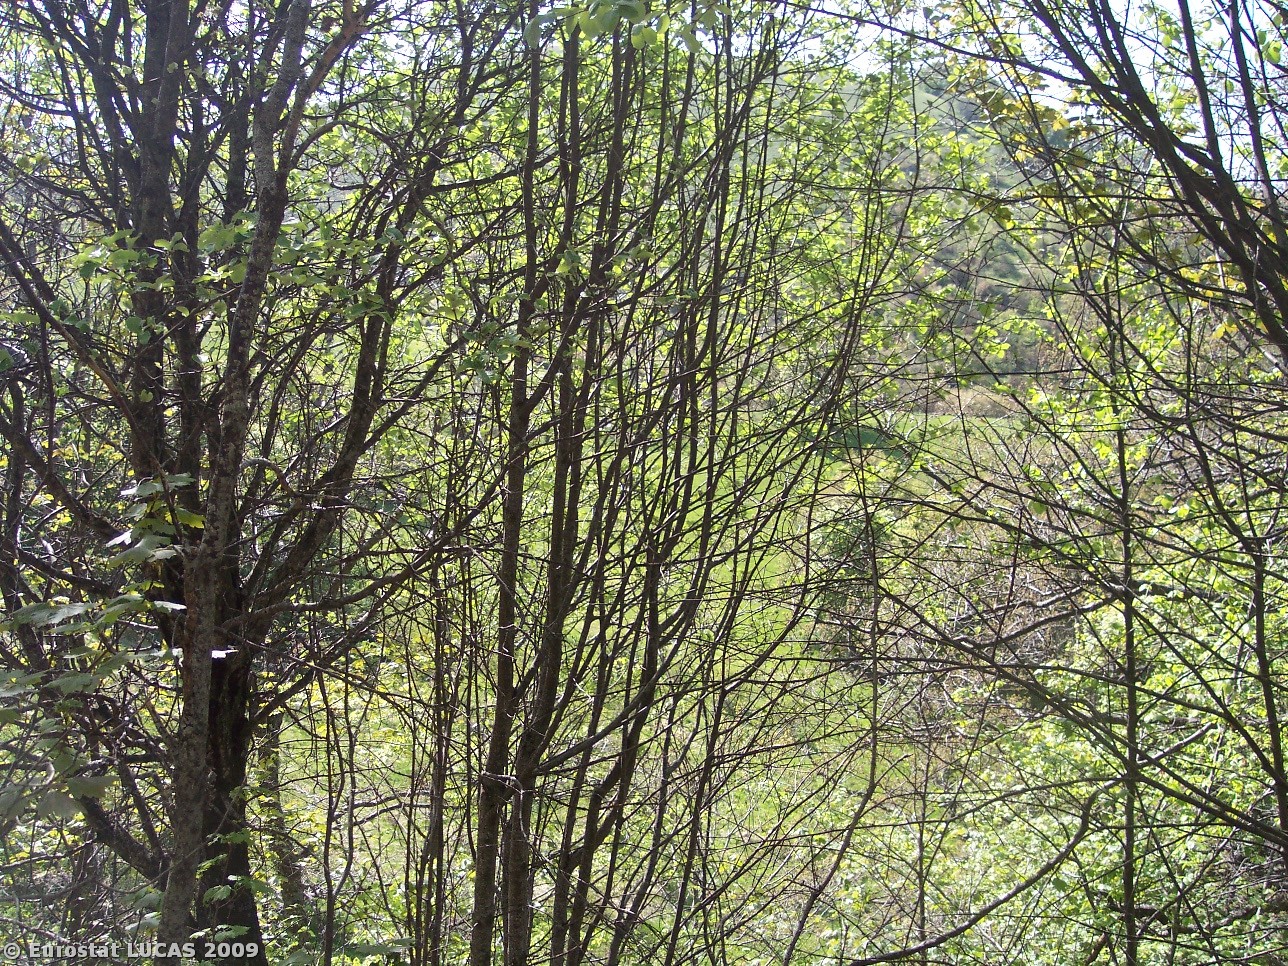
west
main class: Woodland
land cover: Broadleaved woodland
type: thermophilous deciduous forest
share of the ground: > 75 %
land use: Forestry
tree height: > 5 m
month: May
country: IT
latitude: 42.8303
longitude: 12.8662
